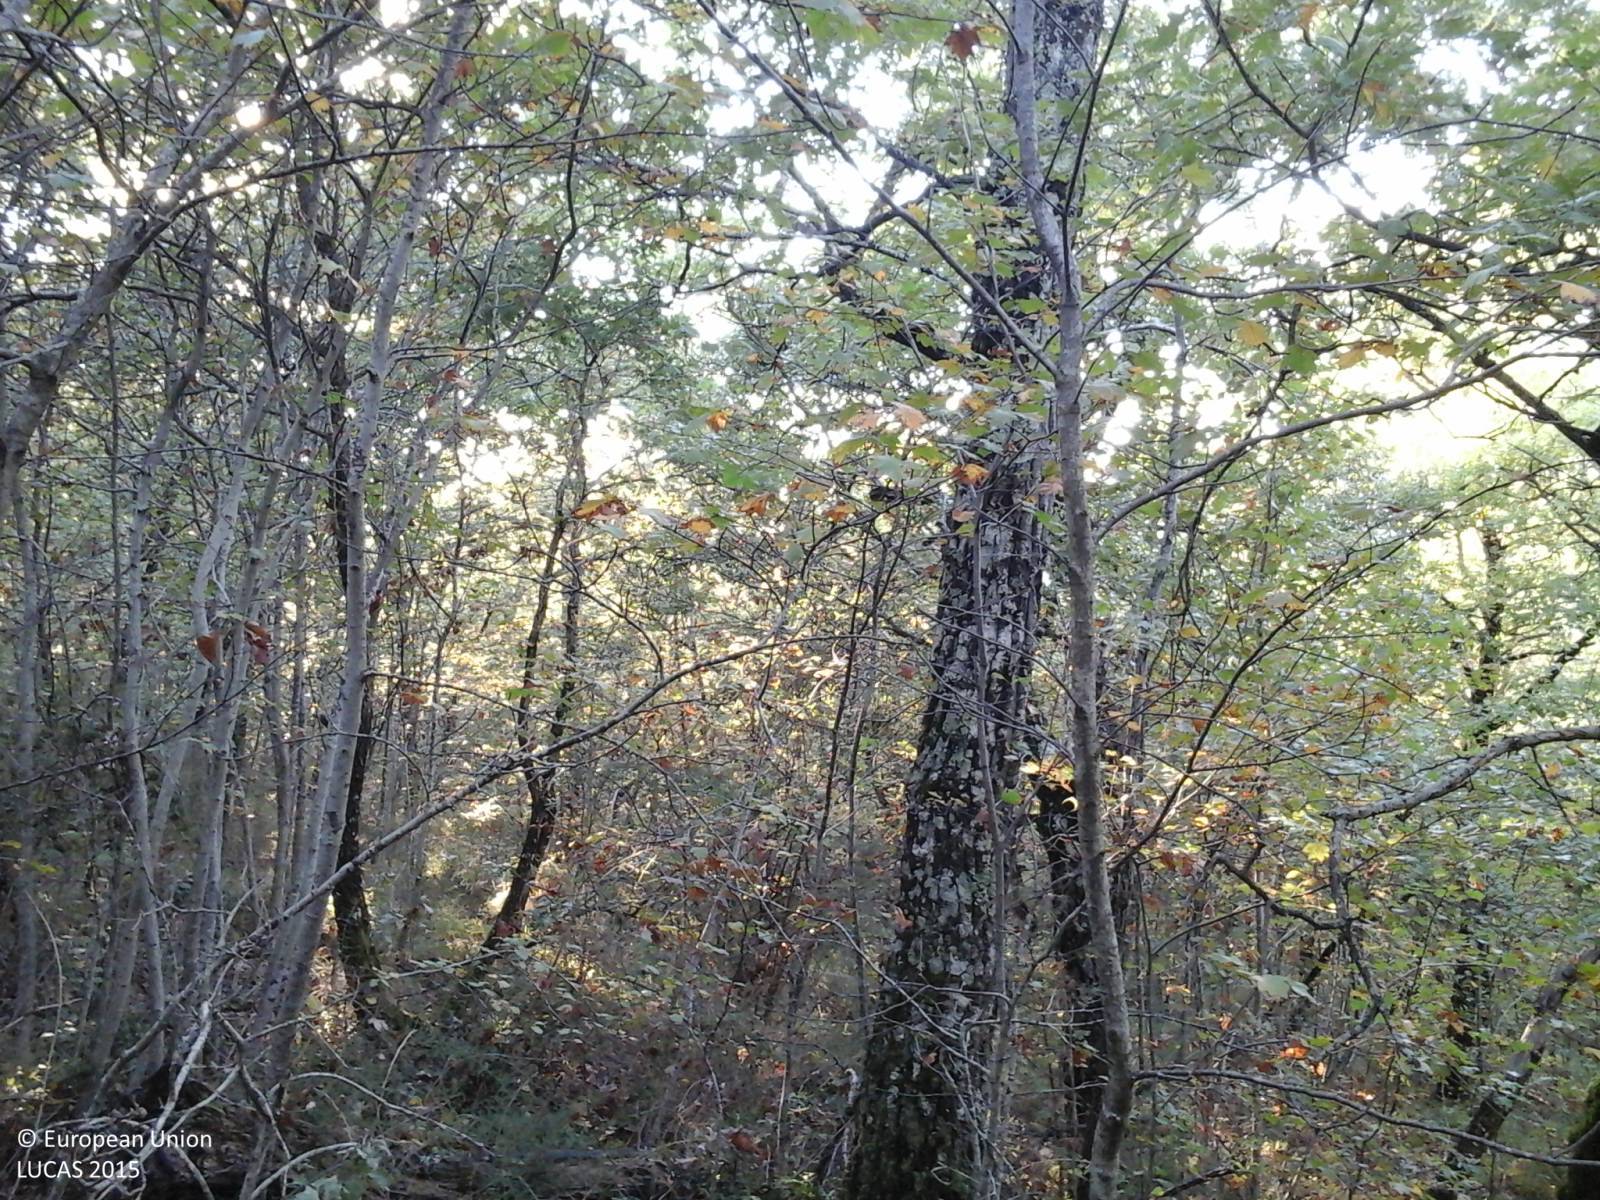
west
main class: Woodland
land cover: Broadleaved woodland
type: thermophilous deciduous forest
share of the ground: > 75 %
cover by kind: broadleaved forest trees 90 %, shrubs 10 %
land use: Forestry
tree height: > 5 m
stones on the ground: 10 - 25 %
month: September
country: IT
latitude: 42.8388
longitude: 12.5493
